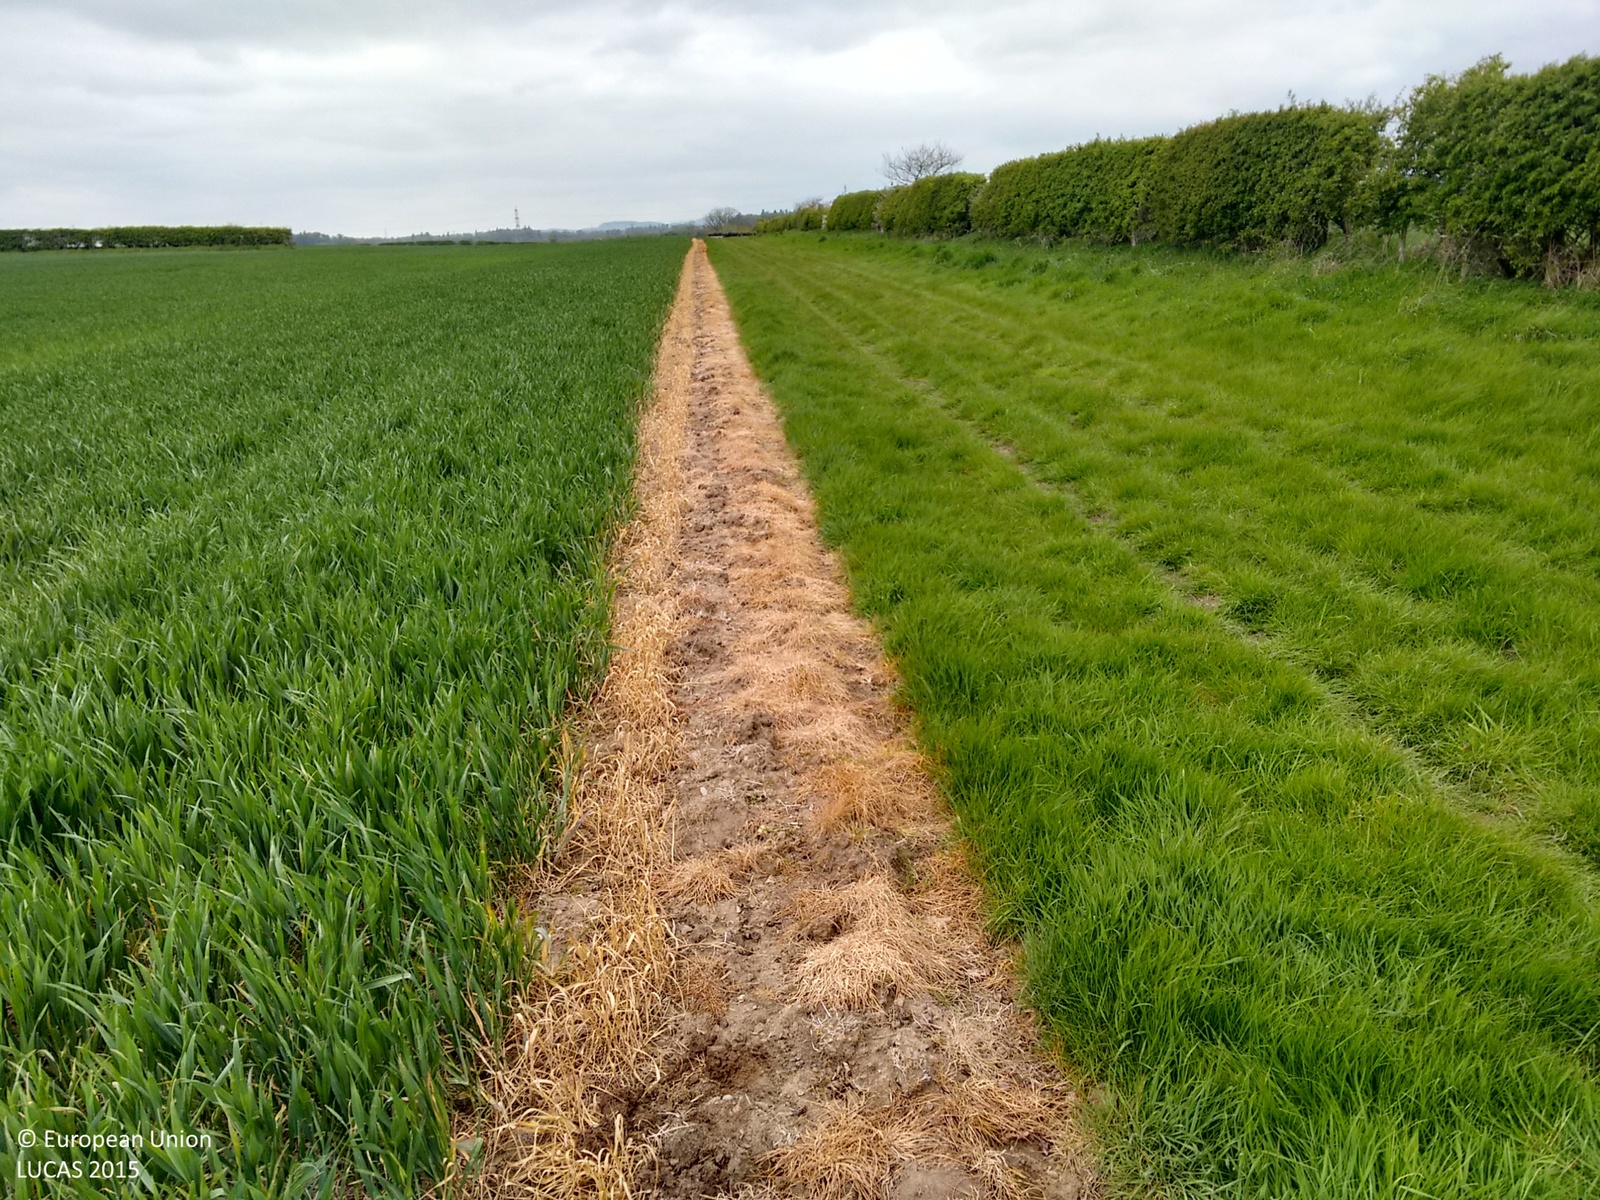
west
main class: Cropland
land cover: Common wheat
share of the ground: > 75 %
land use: Agriculture (excluding fallow land and kitchen gardens)
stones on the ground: < 10 %
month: May
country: GB
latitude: 55.7031
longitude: -2.2939
